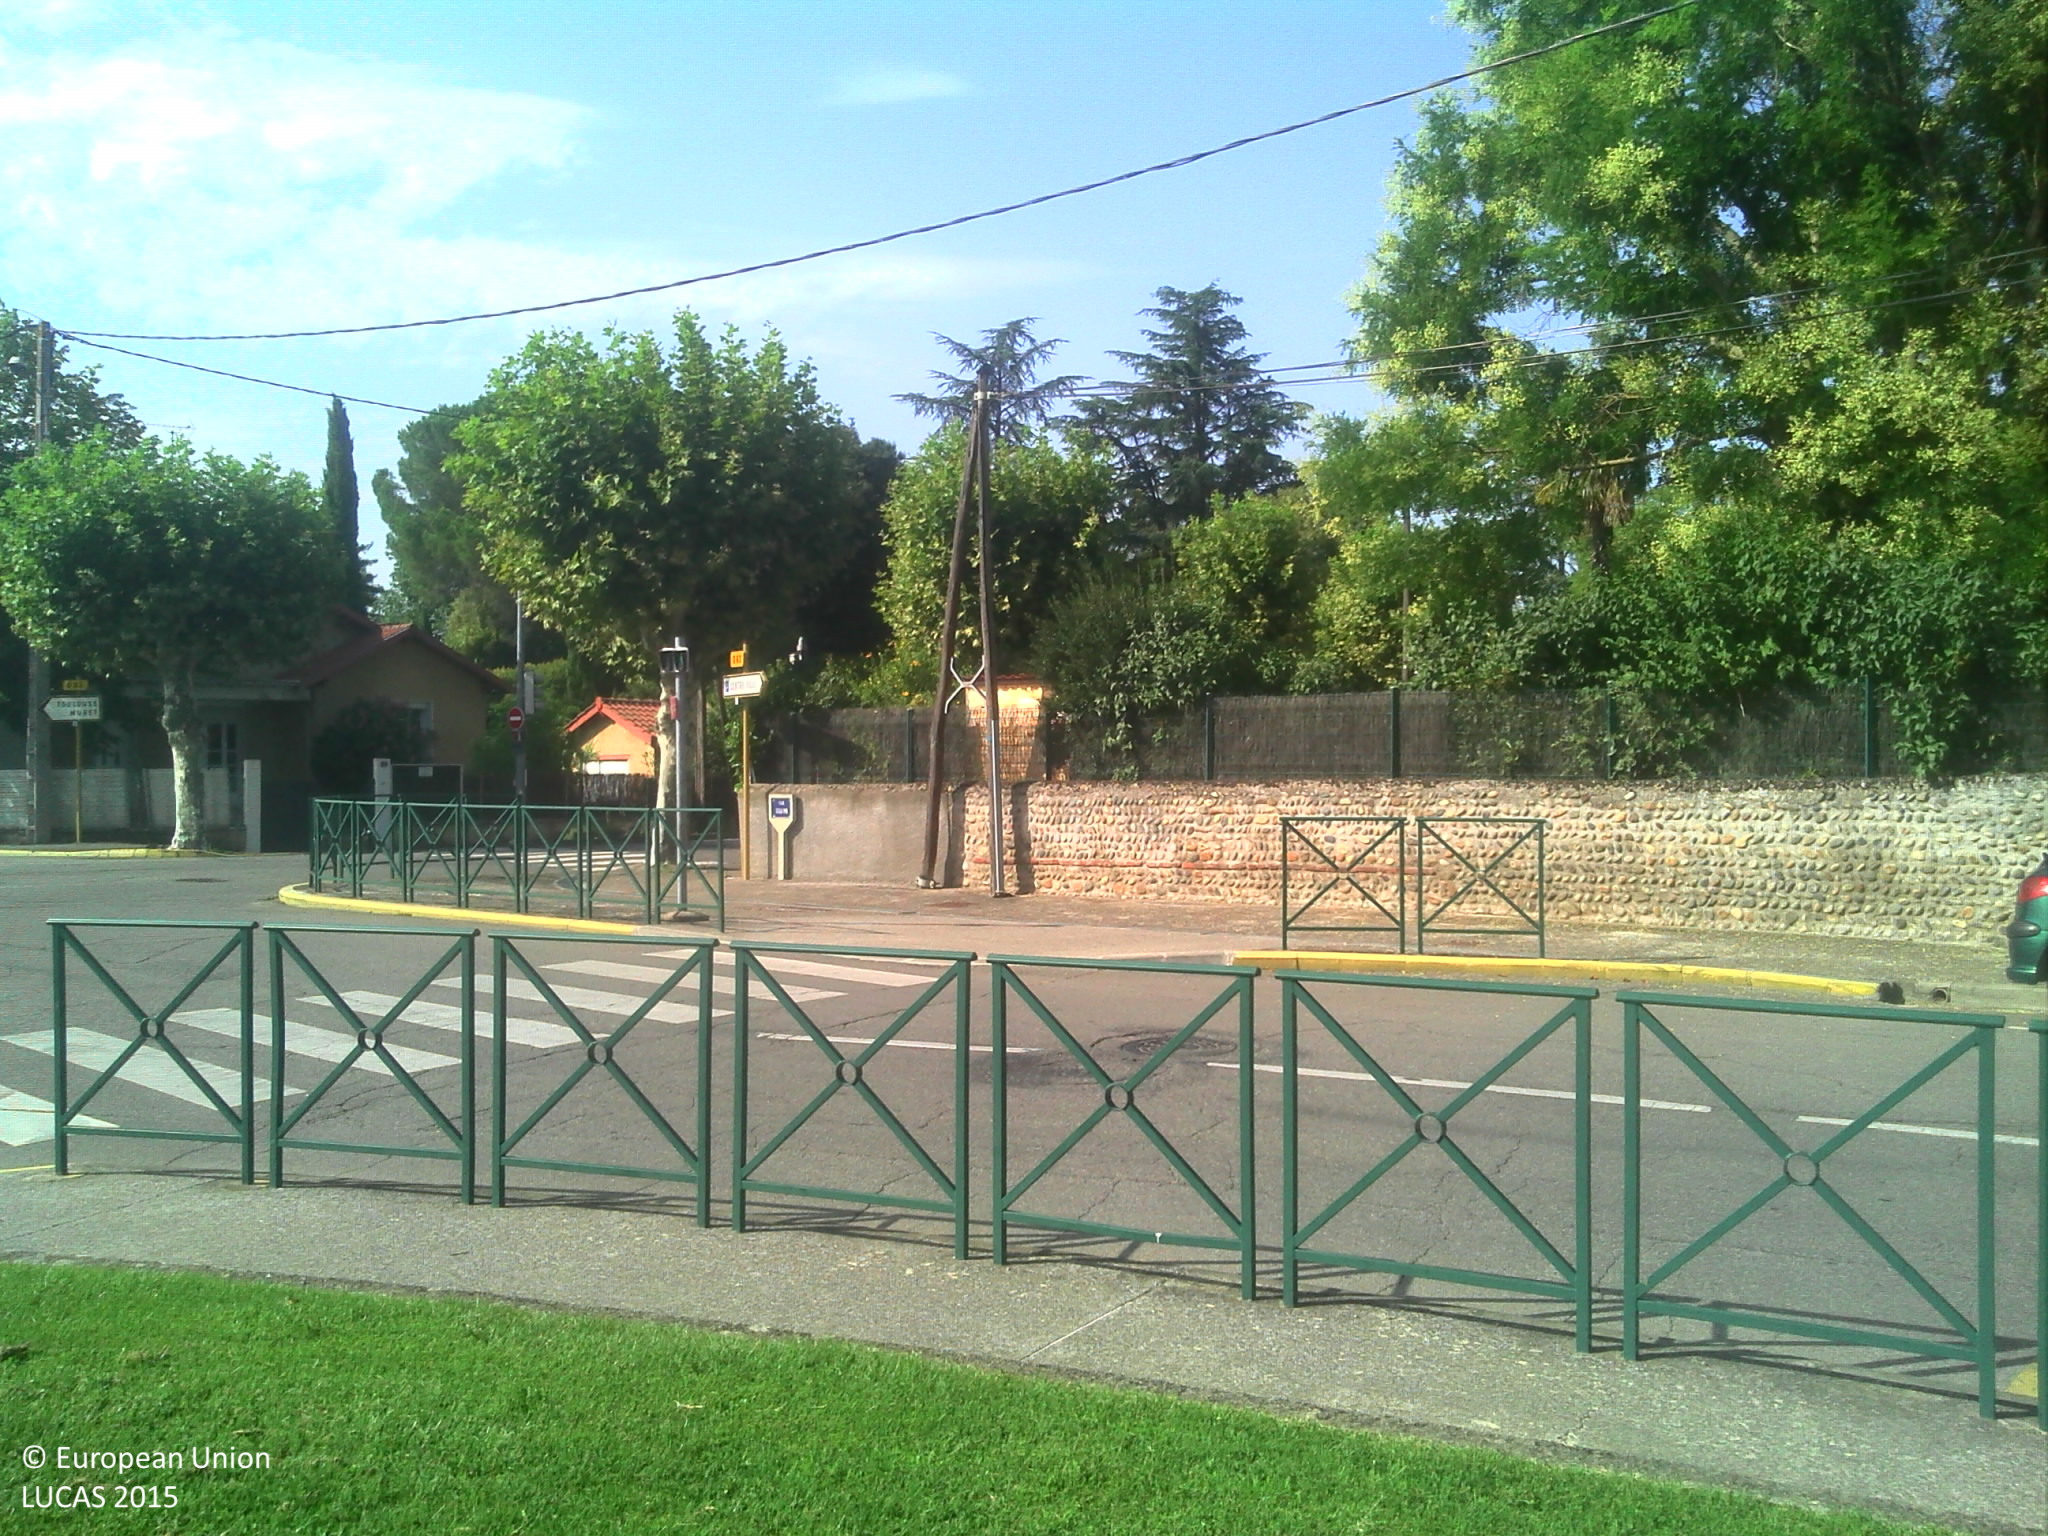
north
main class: Grassland
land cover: Grassland without tree/shrub cover
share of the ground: > 75 %
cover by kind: herbaceous plants 100 %
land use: Community services
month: August
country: FR
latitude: 43.5219
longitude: 1.4044
